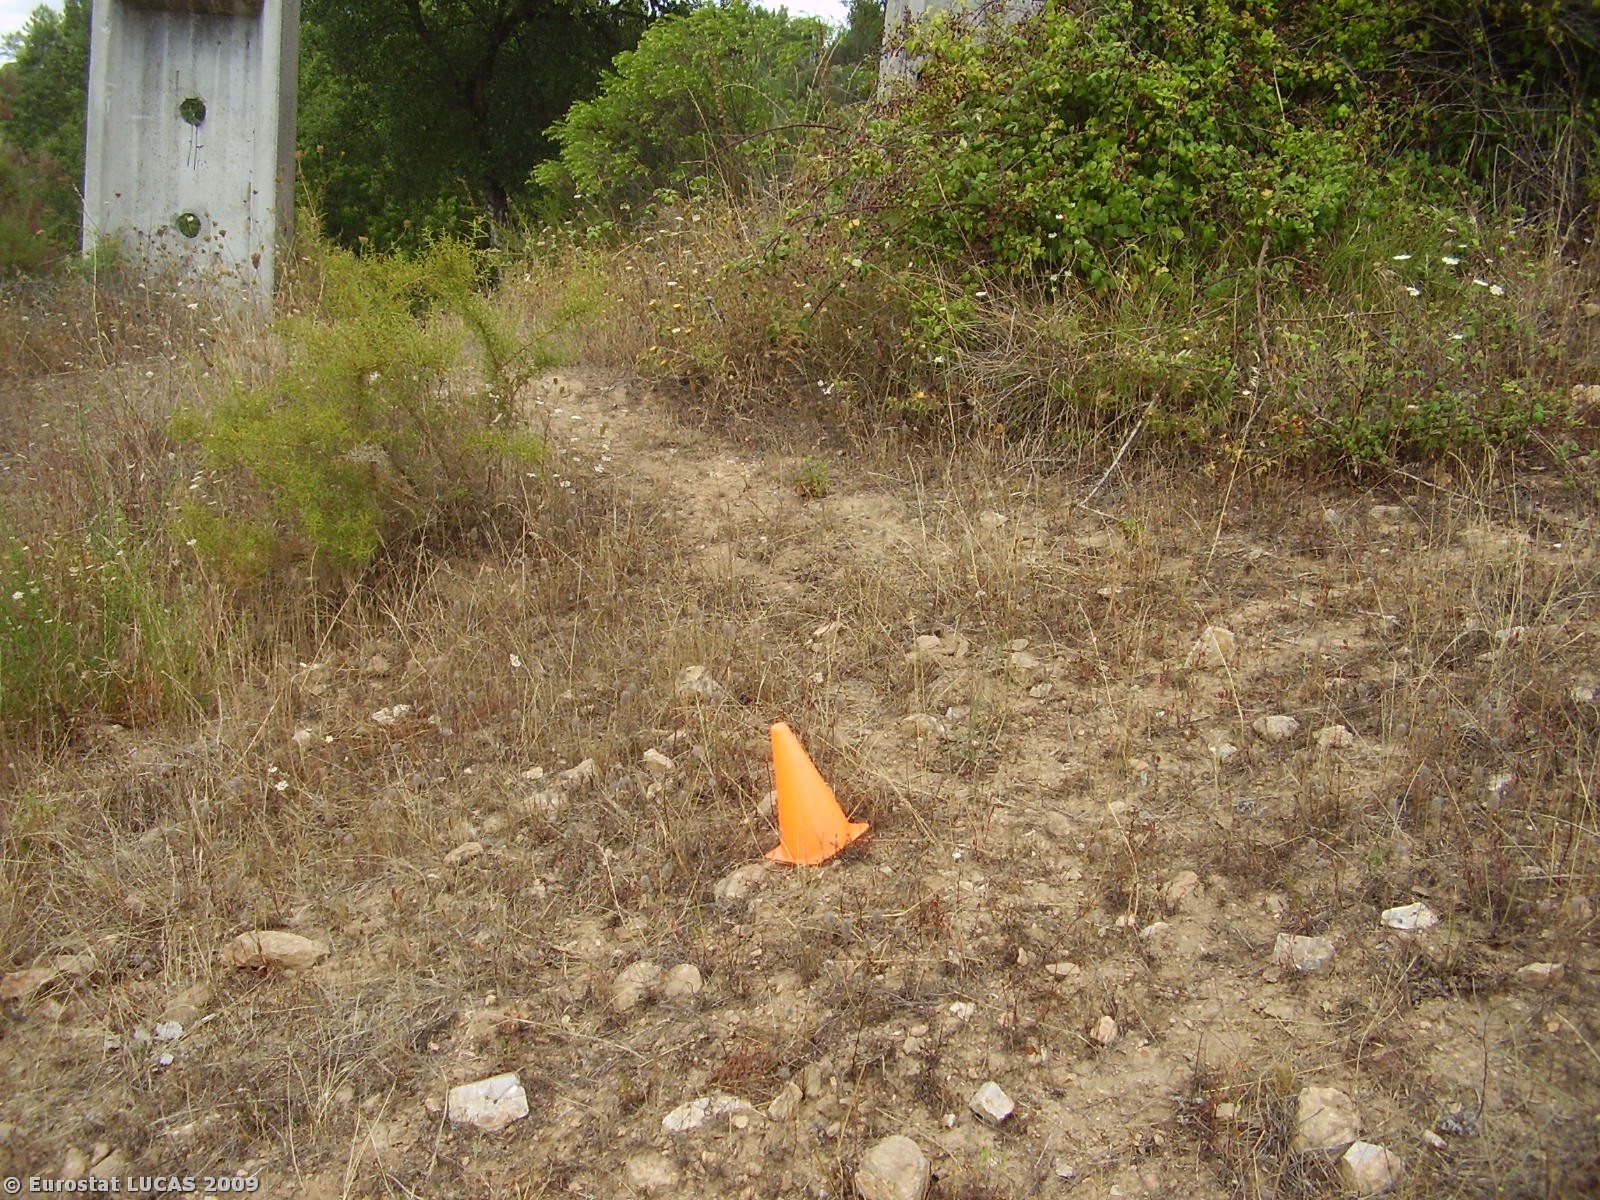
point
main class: Grassland
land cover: Grassland with sparse tree/shrub cover
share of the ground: 50 - 75 %
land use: Fallow land
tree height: > 5 m
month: July
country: PT
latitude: 39.5331
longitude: -8.3707
